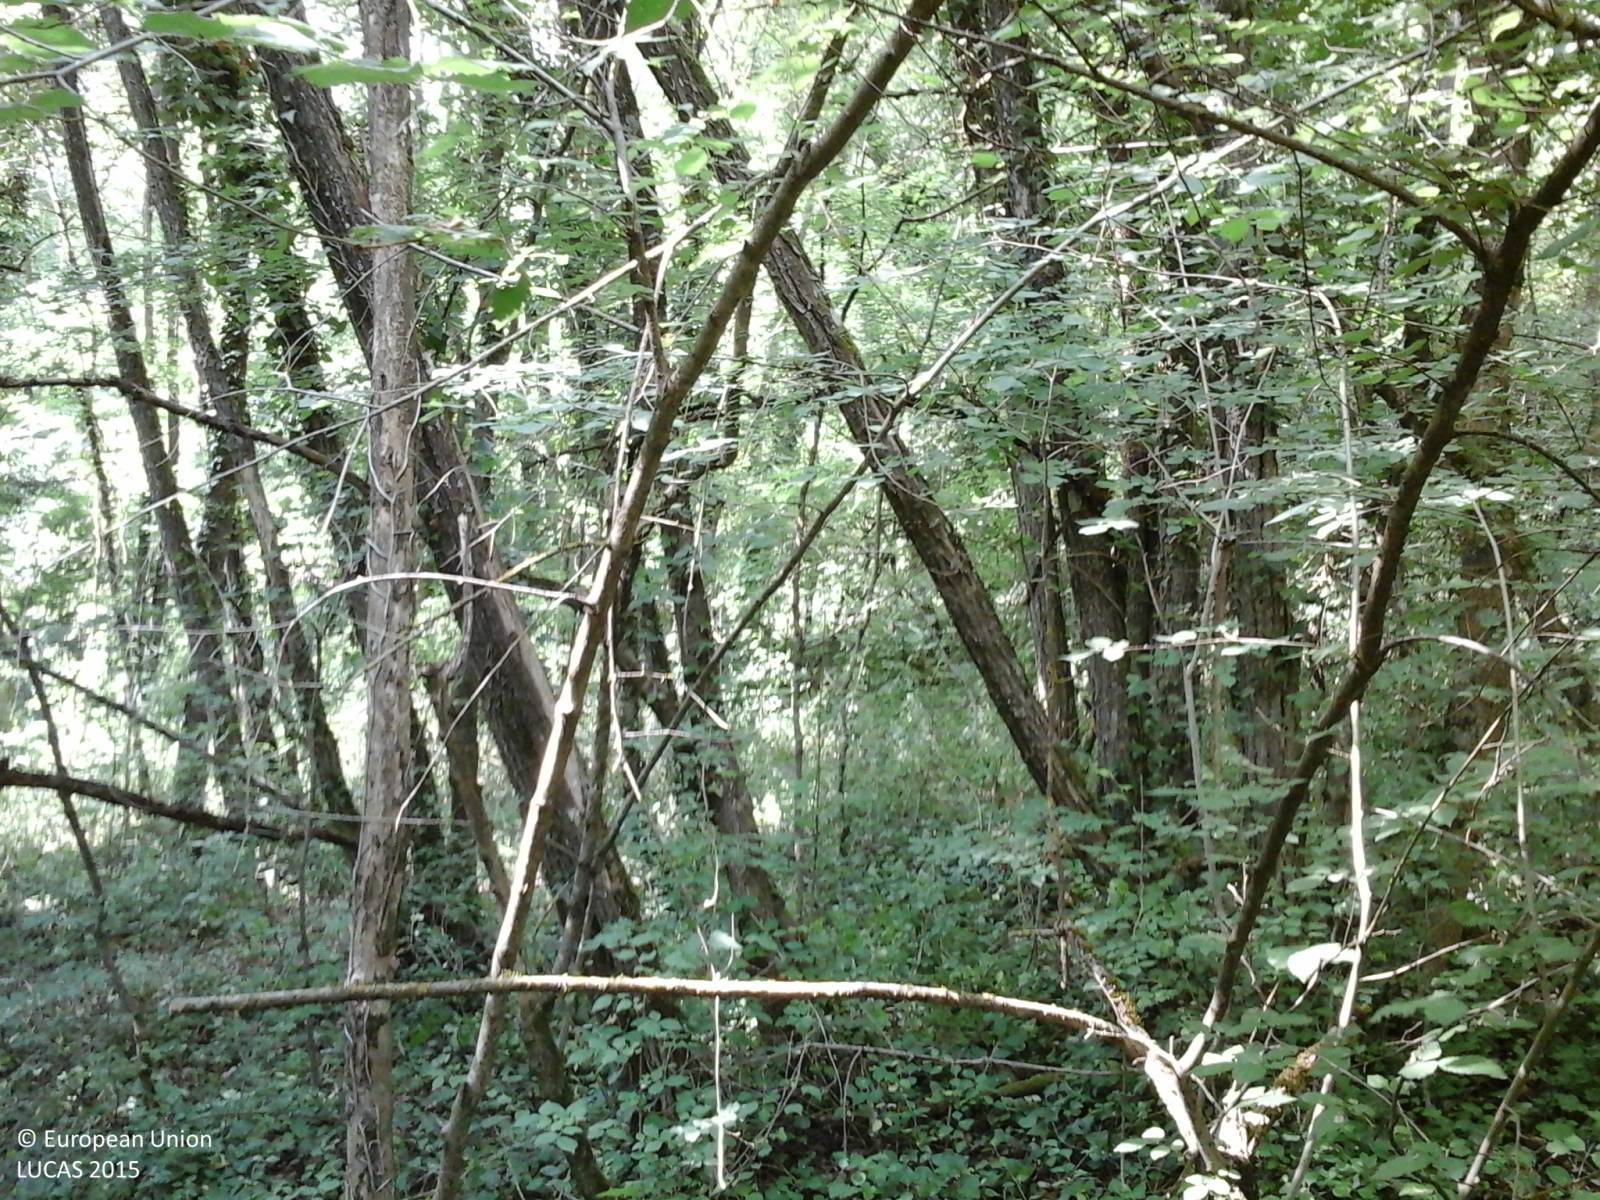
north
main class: Woodland
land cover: Broadleaved woodland
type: thermophilous deciduous forest
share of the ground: > 75 %
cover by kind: broadleaved forest trees 100 %
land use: Forestry
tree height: > 5 m
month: June
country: IT
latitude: 42.0371
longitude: 13.3827
